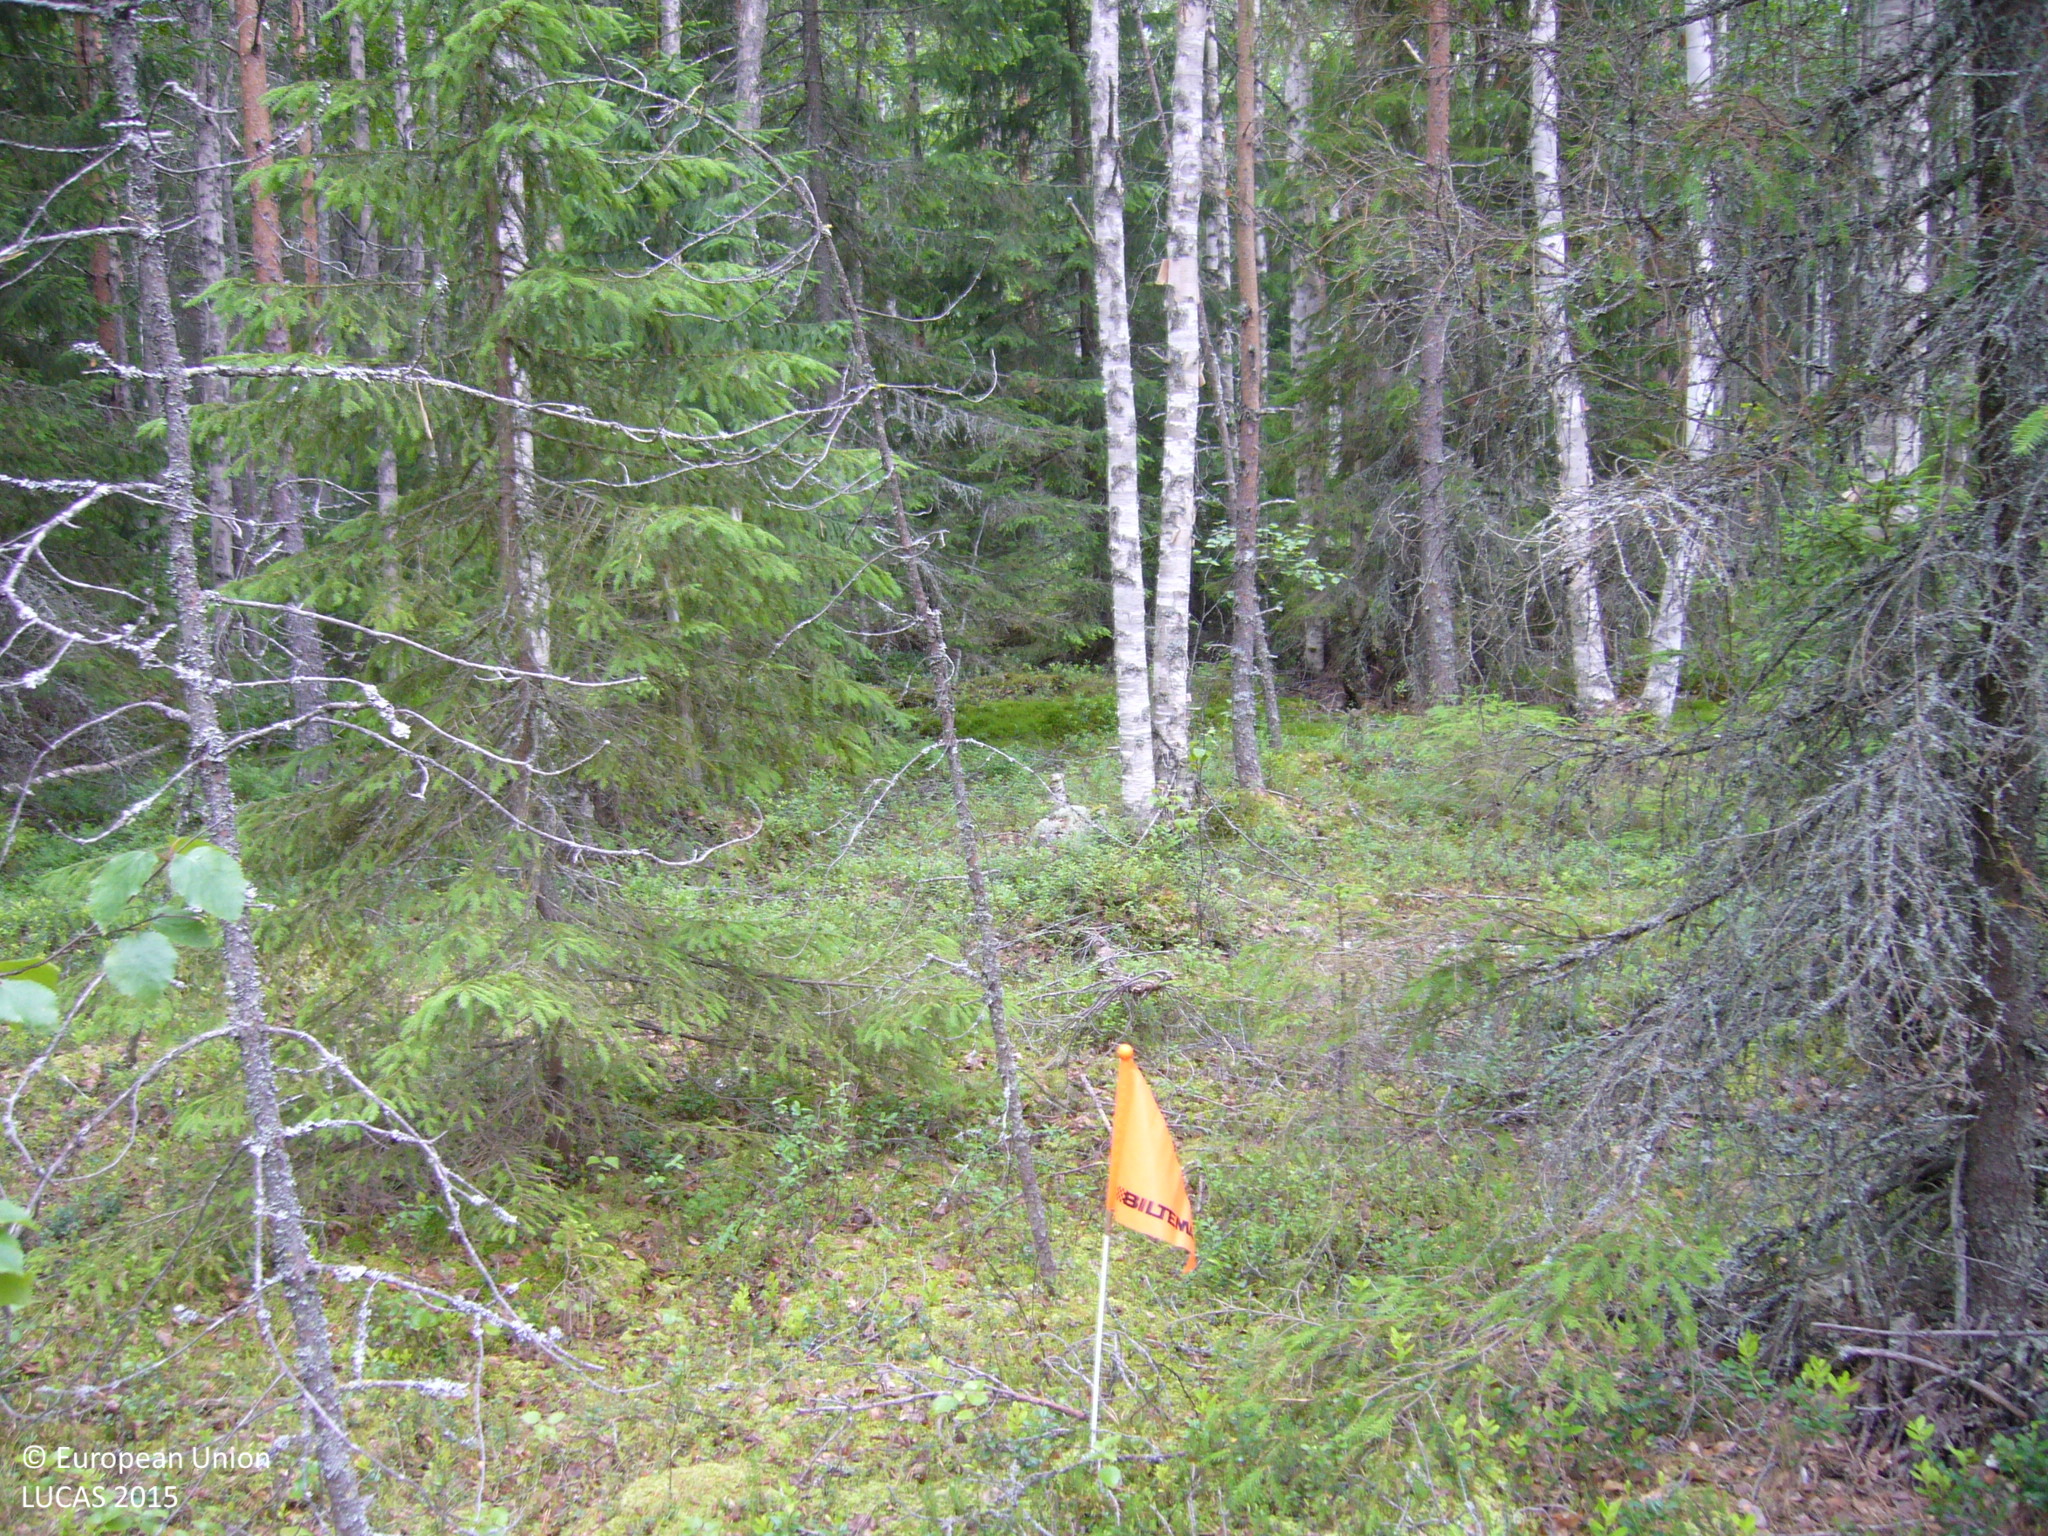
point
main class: Woodland
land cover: Pine dominated mixed woodland
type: boreal forest
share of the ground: > 75 %
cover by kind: coniferous forest trees 50 %, broadleaved forest trees 30 %, shrubs 20 %
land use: Forestry
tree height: > 5 m
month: July
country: FI
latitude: 63.5037
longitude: 26.0052
